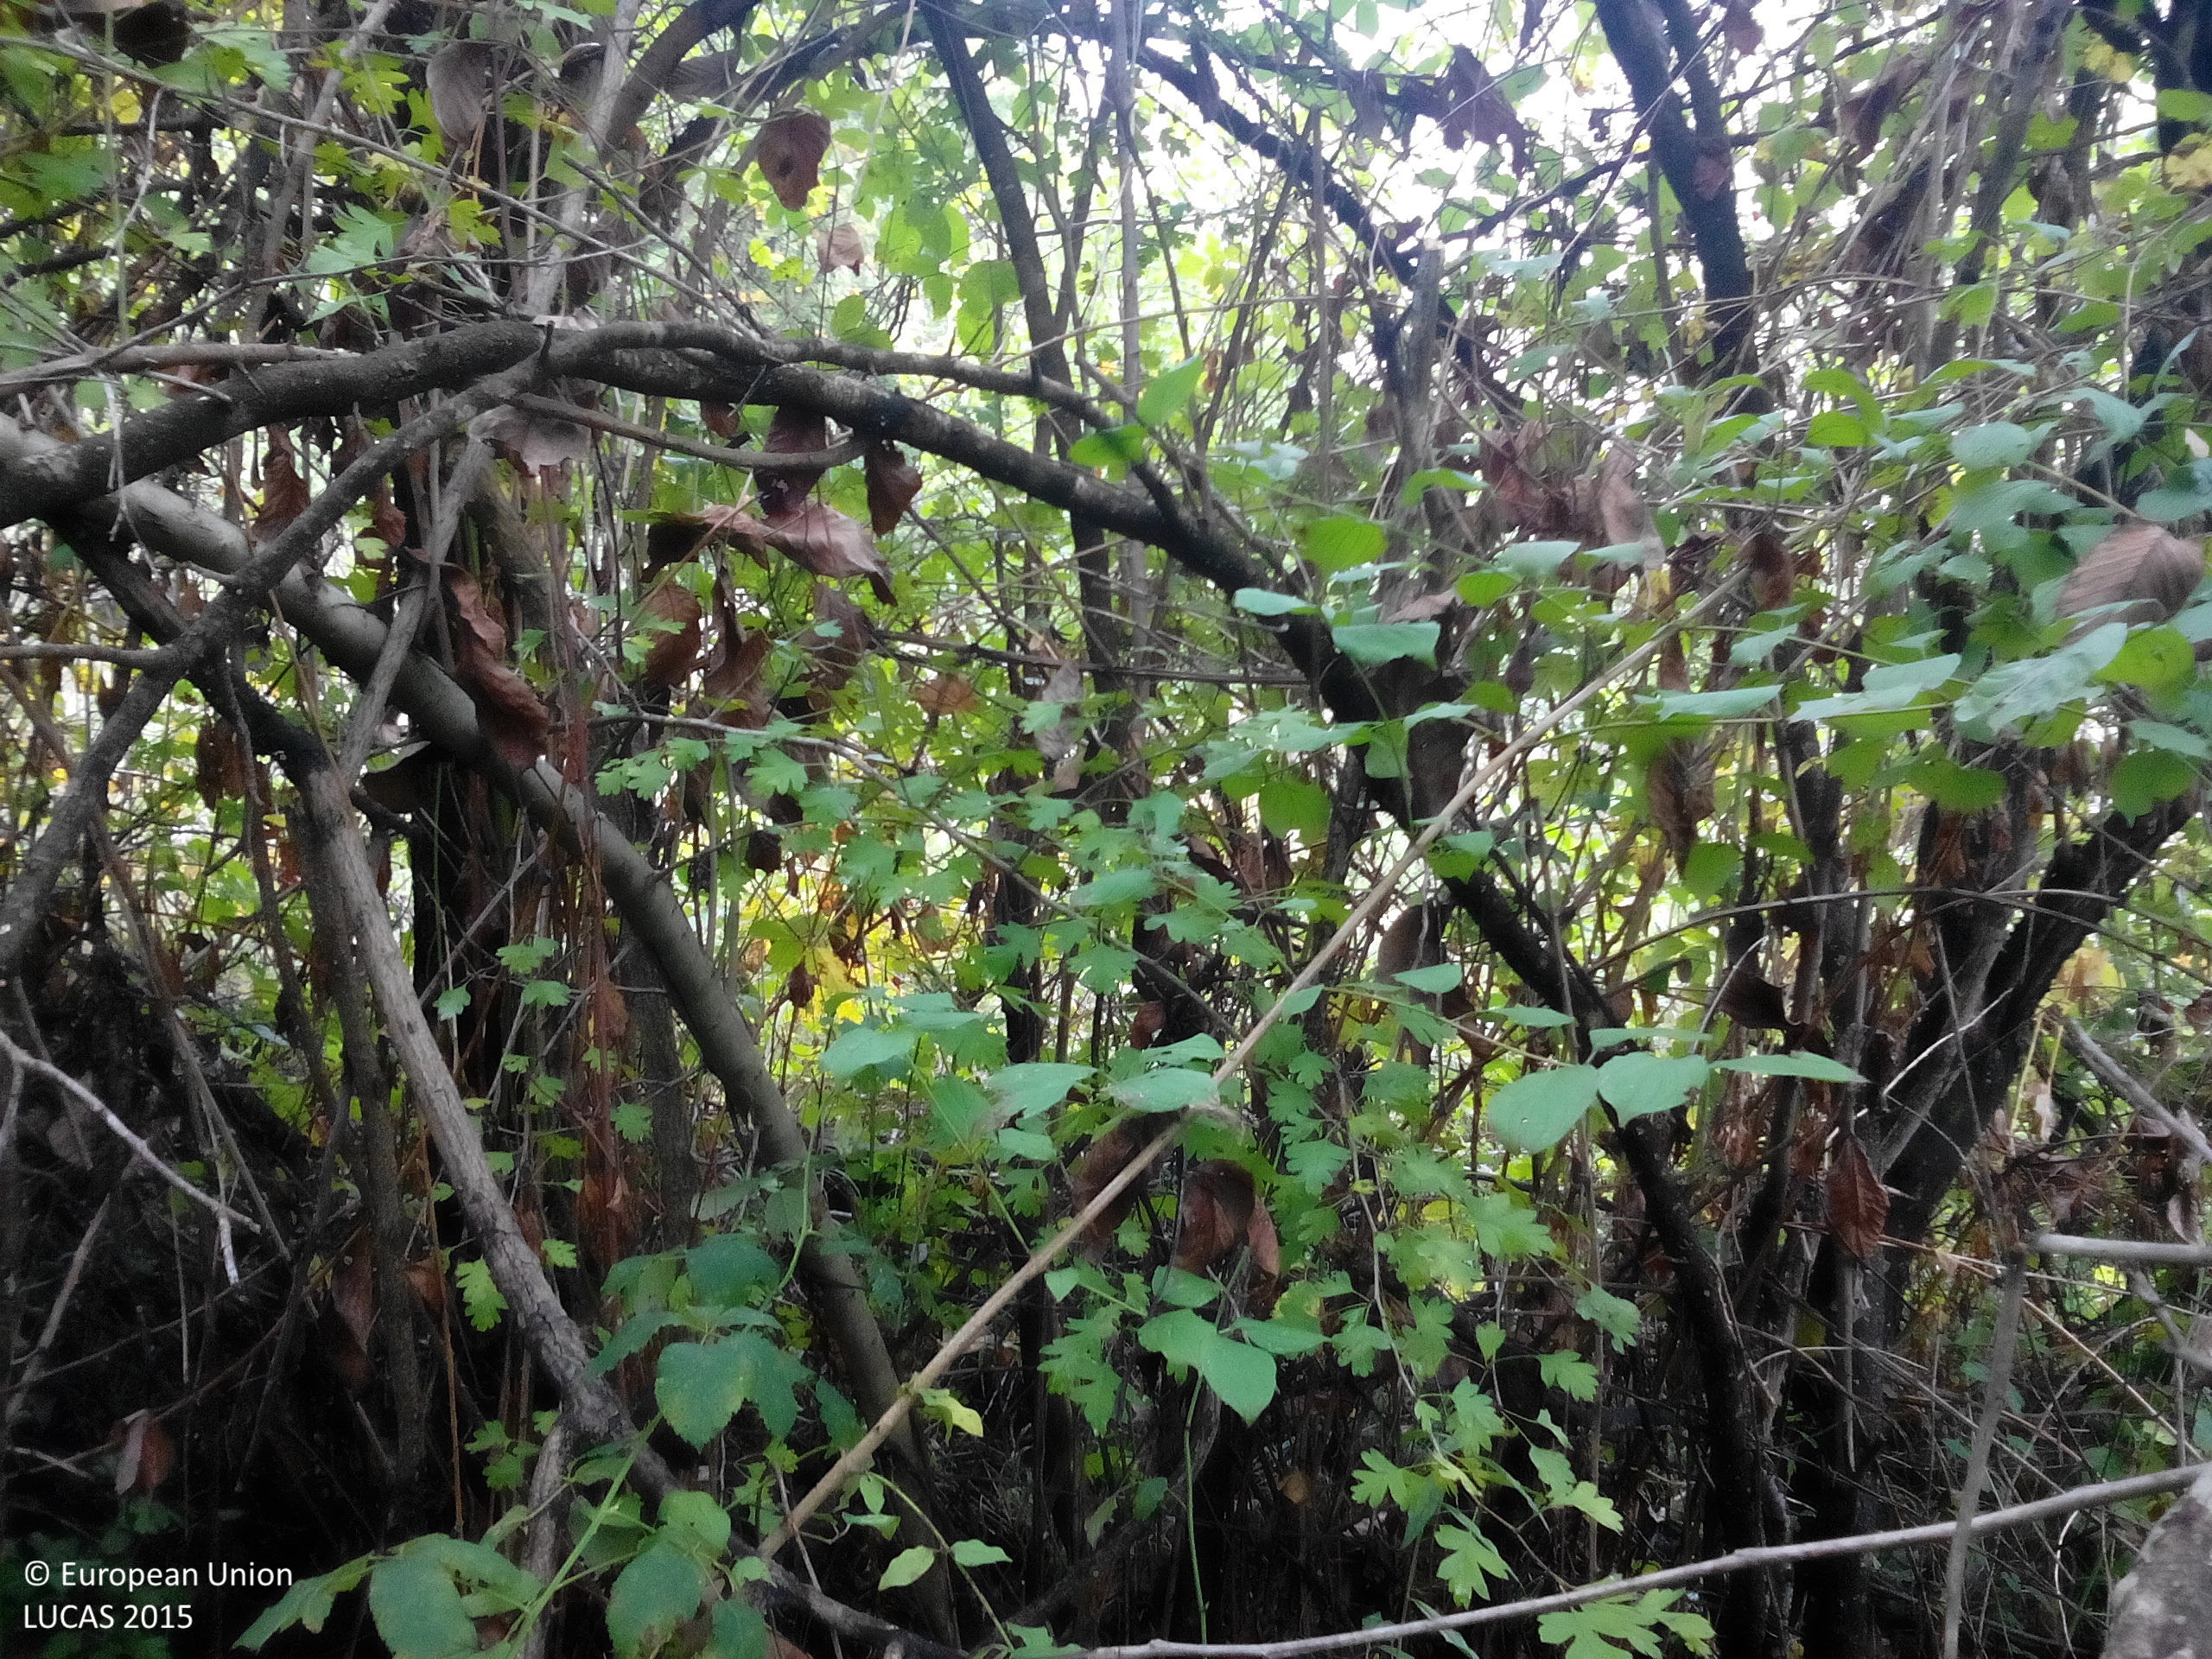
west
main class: Woodland
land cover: Broadleaved woodland
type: mesophytic deciduous forest
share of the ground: > 75 %
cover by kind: broadleaved forest trees 90 %, shrubs 5 %, herbaceous plants 5 %
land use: Semi-natural and natural areas not in use
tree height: > 5 m
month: October
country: BG
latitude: 43.1218
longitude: 23.9994
